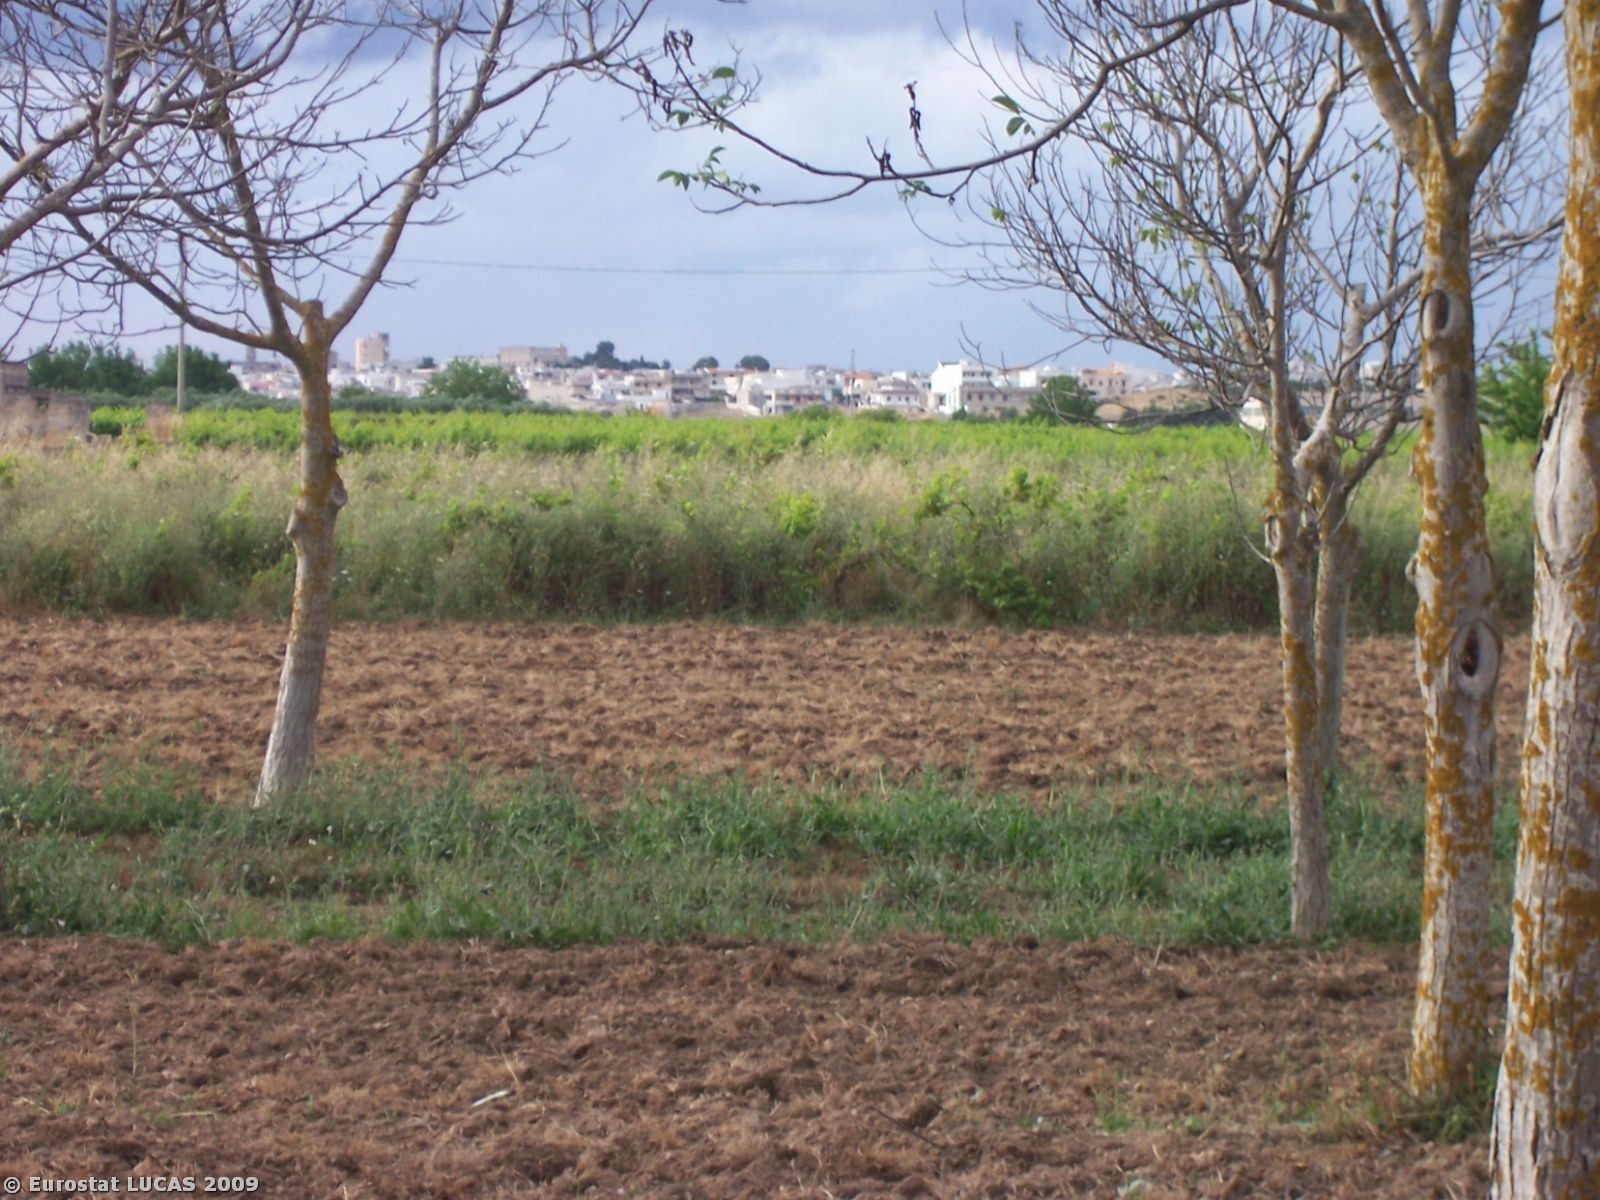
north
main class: Cropland
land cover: Nuts trees
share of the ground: 50 - 75 %
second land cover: Bare land
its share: > 75 %
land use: Agriculture (excluding fallow land and kitchen gardens)
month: June
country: IT
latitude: 40.4335
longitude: 17.5080
